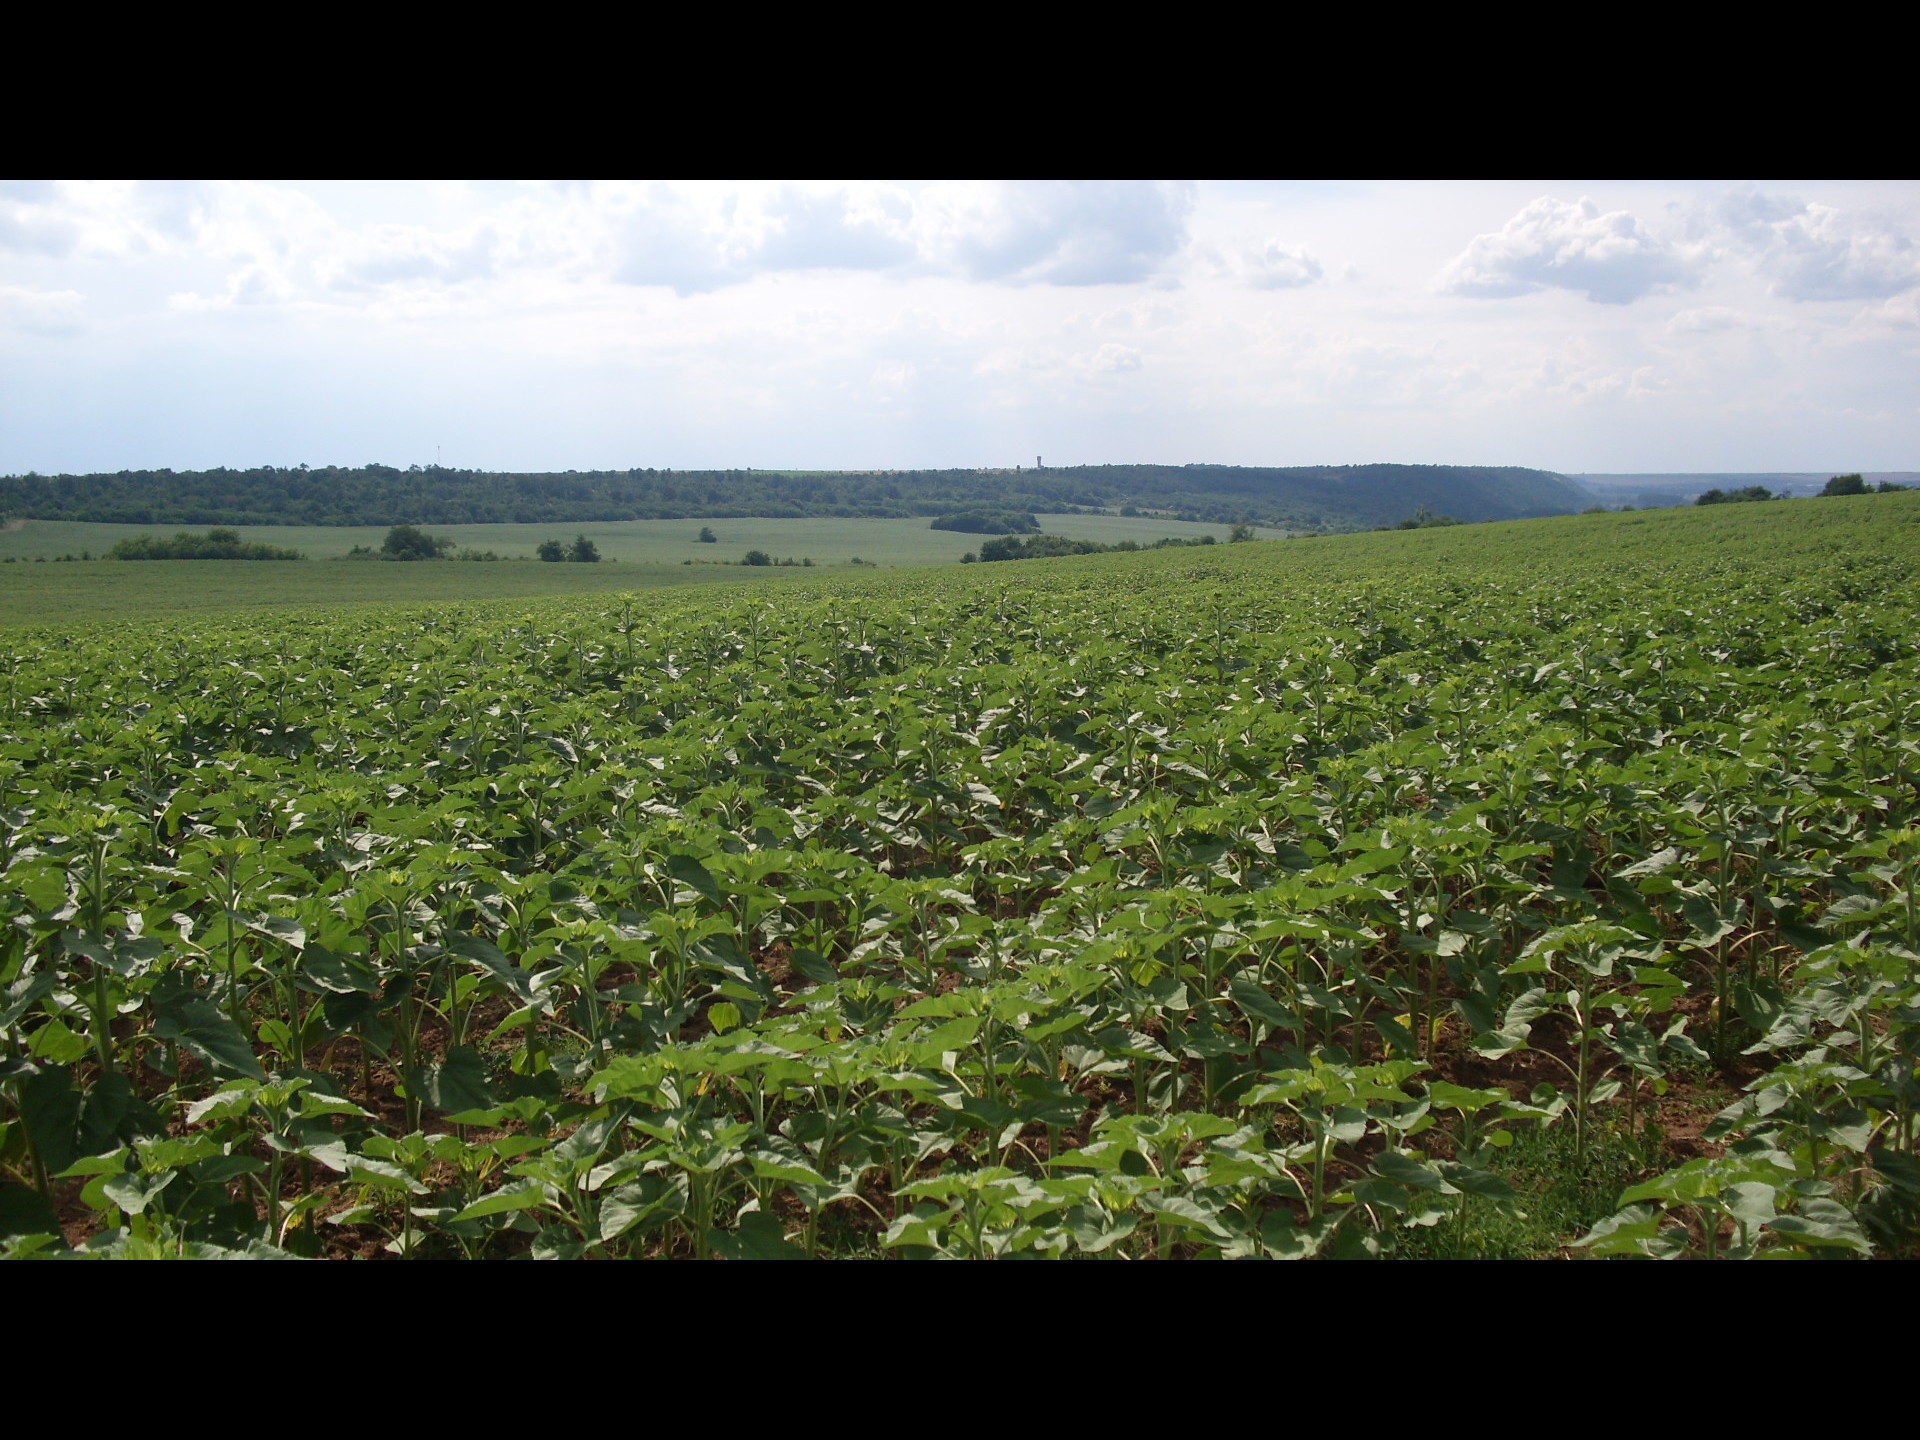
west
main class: Cropland
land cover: Sunflower
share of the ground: 50 - 75 %
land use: Agriculture (excluding fallow land and kitchen gardens)
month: June
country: BG
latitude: 43.4986
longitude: 23.5127
